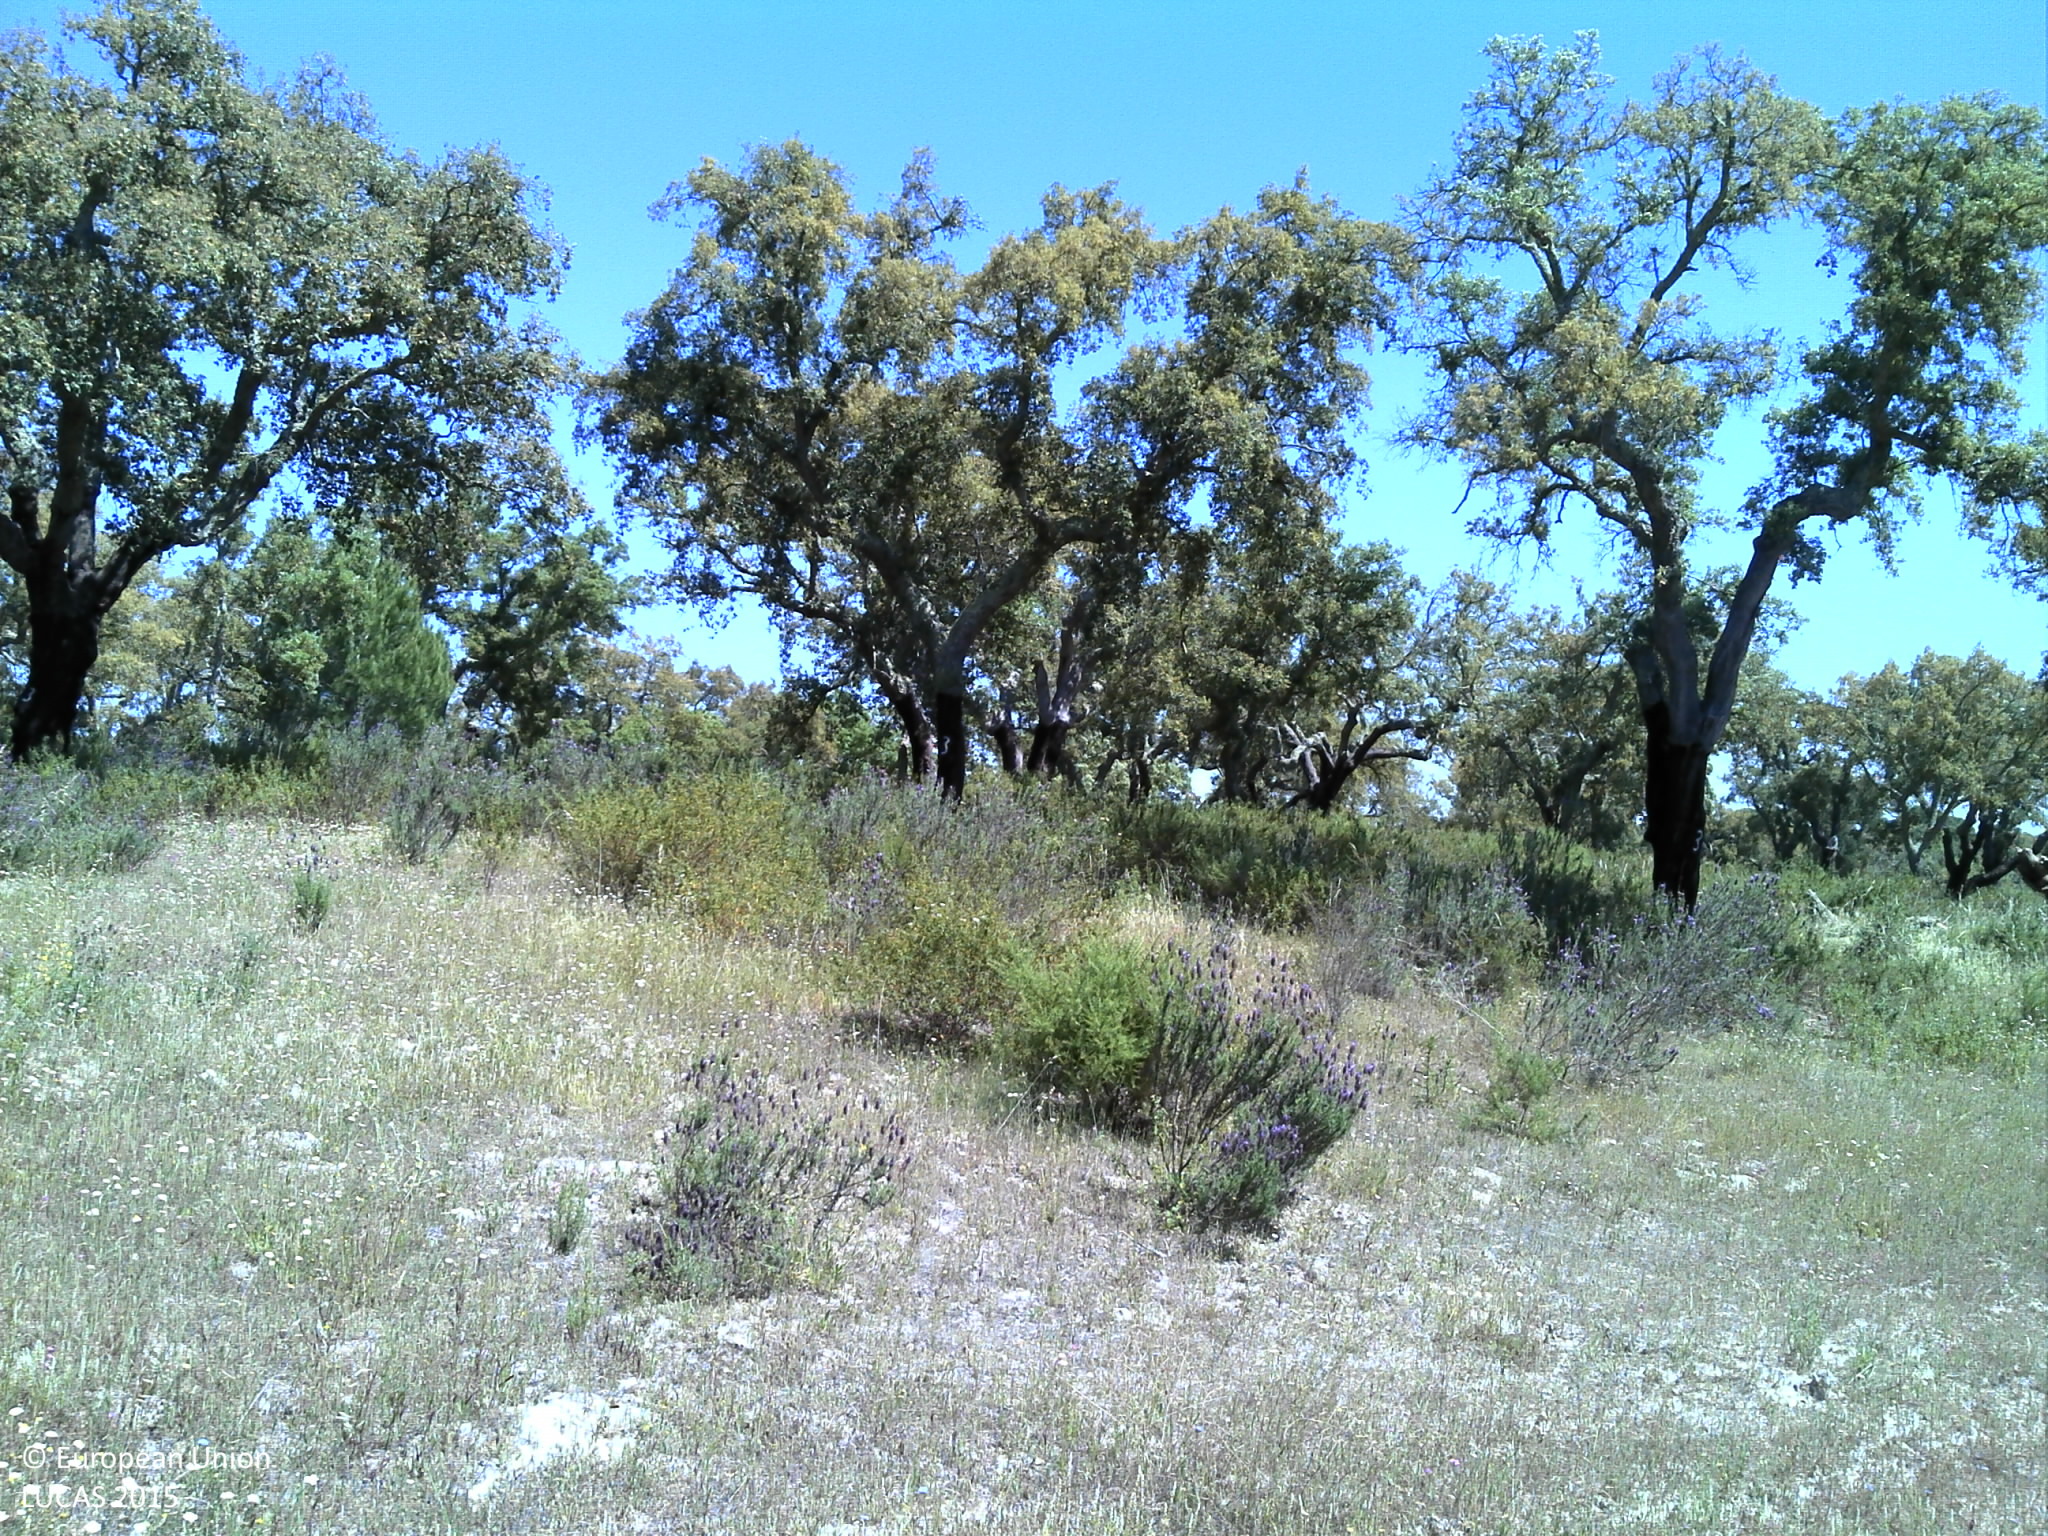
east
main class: Woodland
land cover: Broadleaved woodland
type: broadleaved evergreen forest
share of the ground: 10 - 25 %
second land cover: Grassland without tree/shrub cover
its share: 10 - 25 %
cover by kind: unconsolidated bare surface 55 %, broadleaved forest trees 15 %, shrubs 15 %, herbaceous plants 15 %
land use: Forestry
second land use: Agriculture (excluding fallow land and kitchen gardens)
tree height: > 5 m
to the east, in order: Broadleaved woodland; Grassland without tree/shrub cover; Broadleaved woodland; Other bare soil; Tracks; Other bare soil; Broadleaved woodland; Pine dominated coniferous woodland; Rivers and streams; Broadleaved woodland
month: May
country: PT
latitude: 39.0025
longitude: -8.1480
